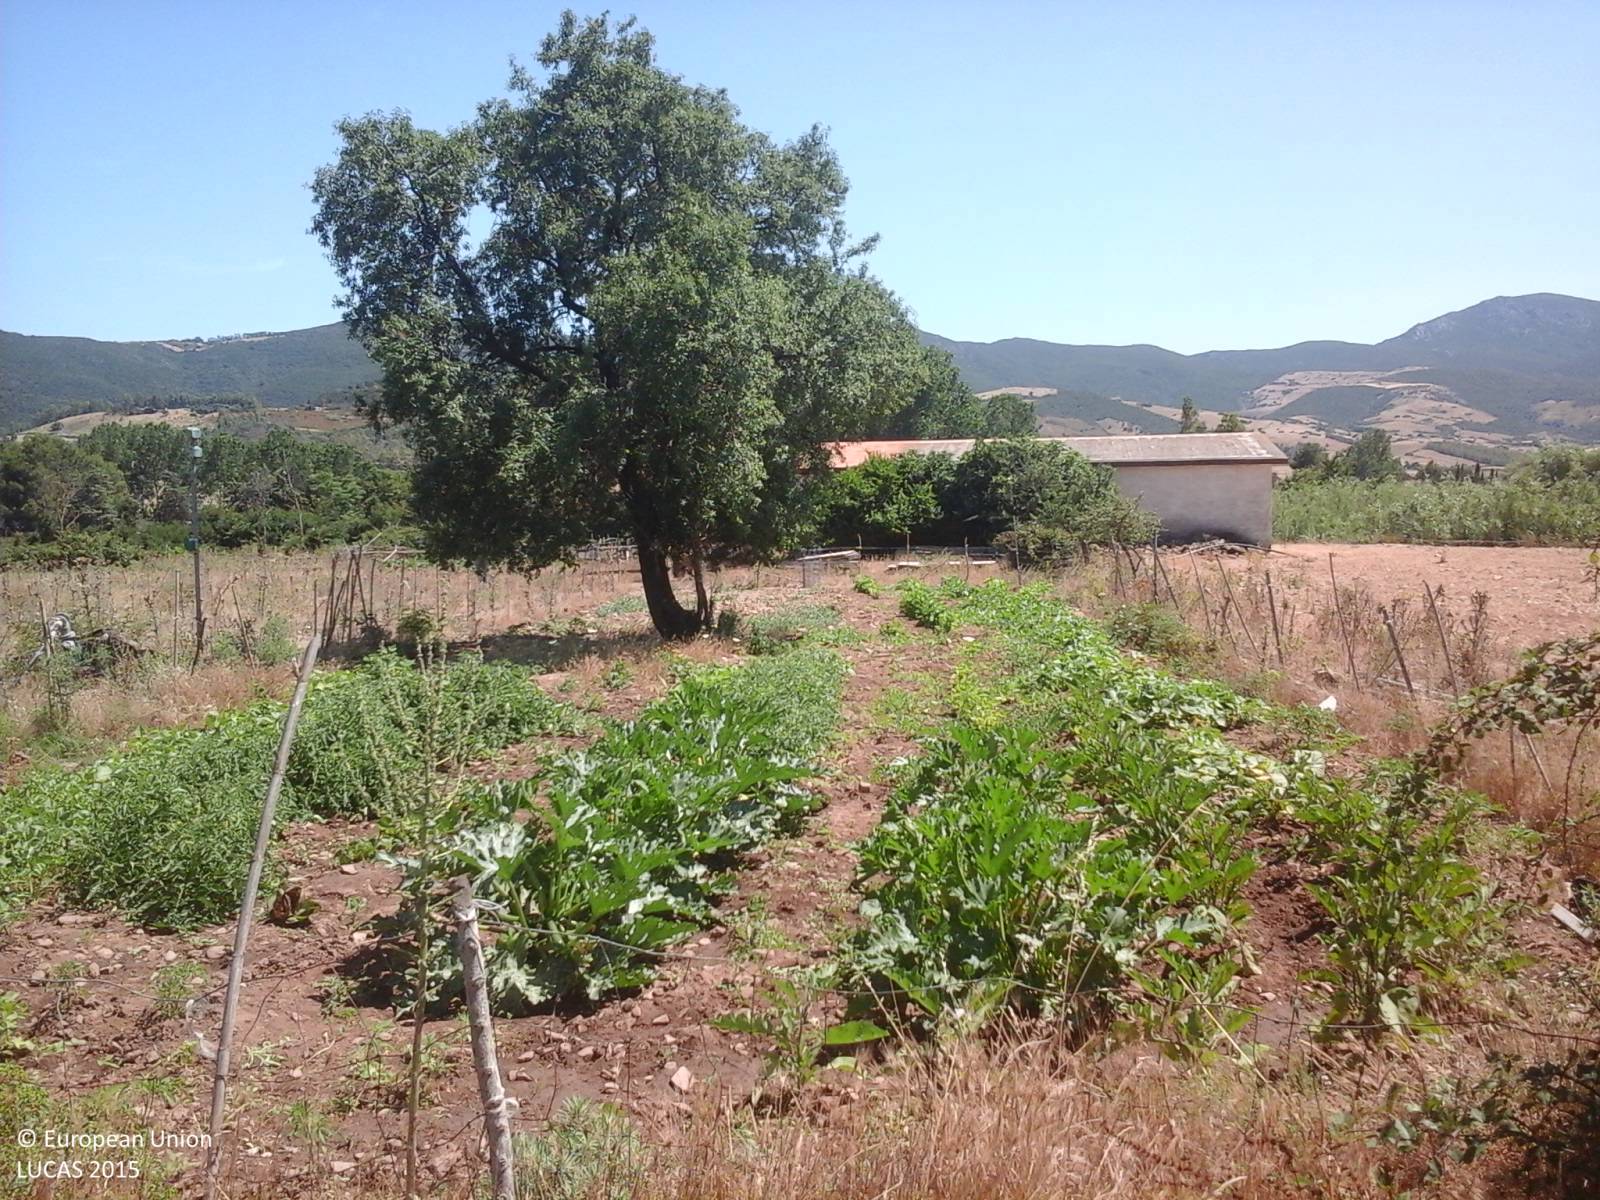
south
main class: Grassland
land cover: Grassland without tree/shrub cover
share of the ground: > 75 %
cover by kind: herbaceous plants 90 %, shrubs 5 %, unconsolidated bare surface 5 %
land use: Agriculture (excluding fallow land and kitchen gardens)
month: June
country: IT
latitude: 40.5564
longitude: 9.6827
